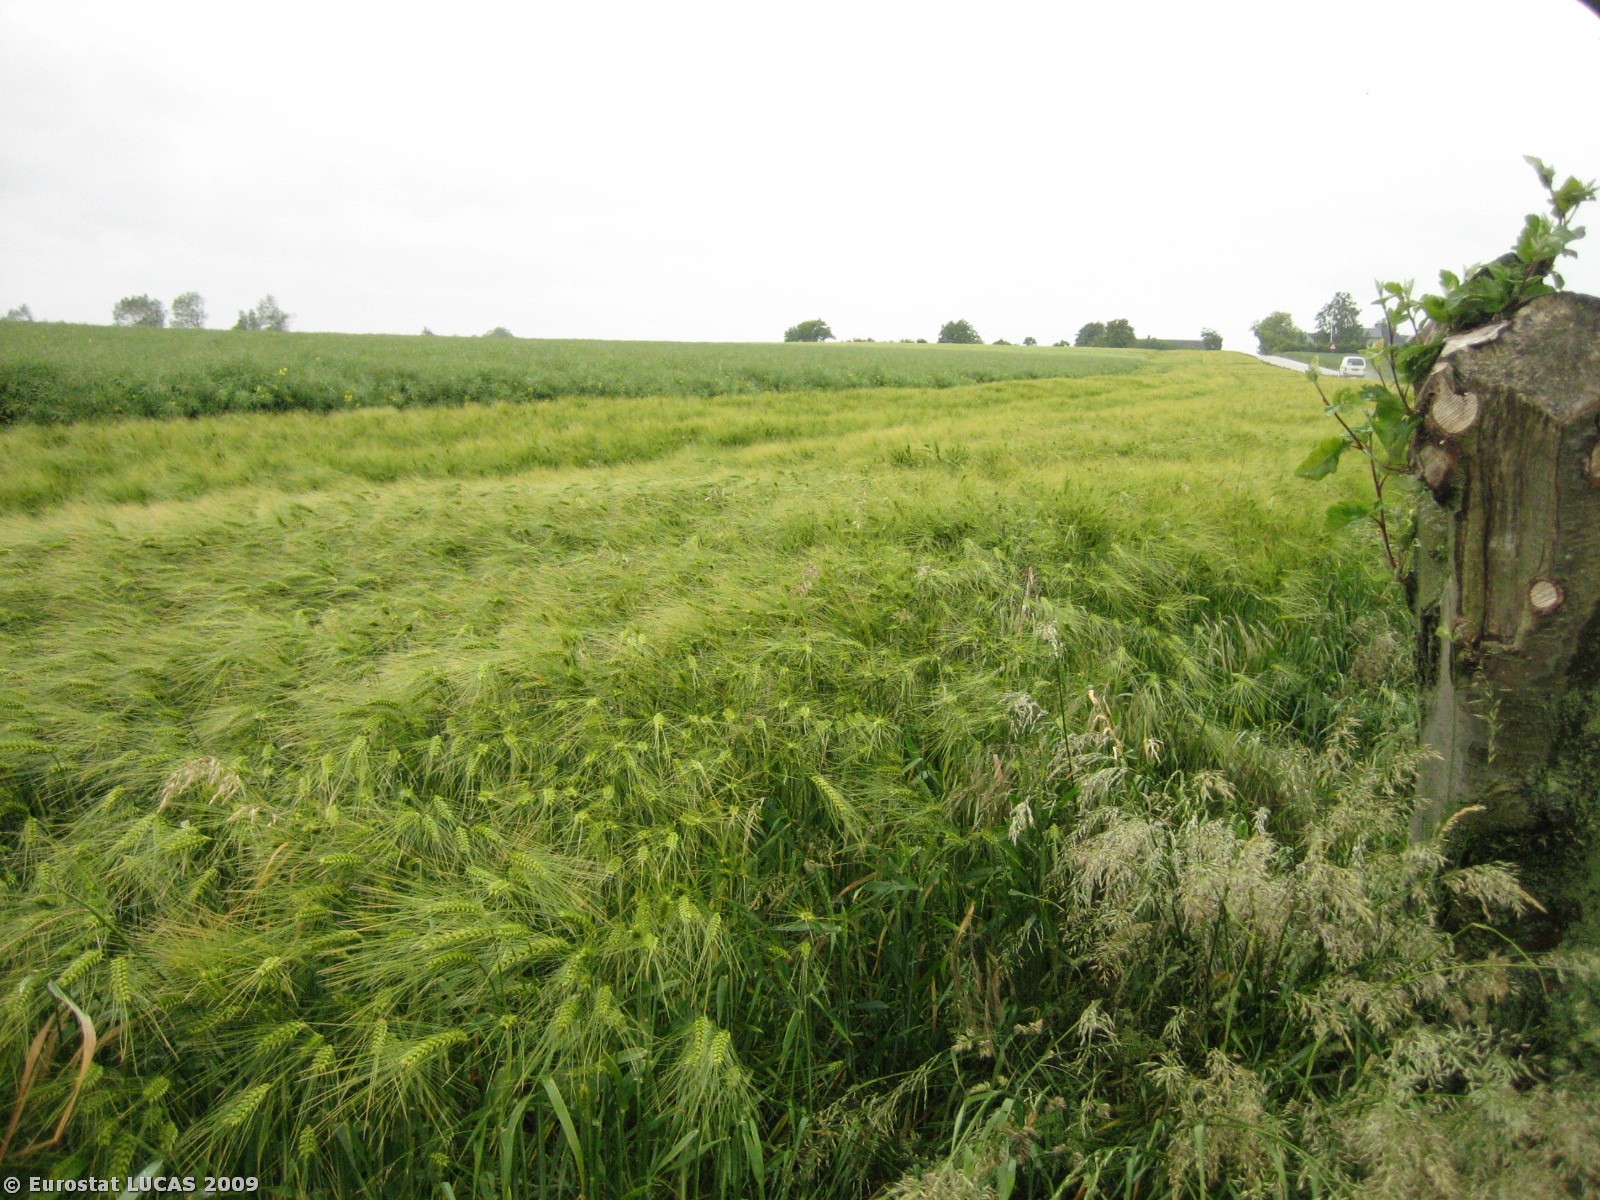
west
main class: Cropland
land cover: Rape and turnip rape
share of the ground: > 75 %
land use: Agriculture (excluding fallow land and kitchen gardens)
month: June
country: DK
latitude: 56.0979
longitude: 10.0161
